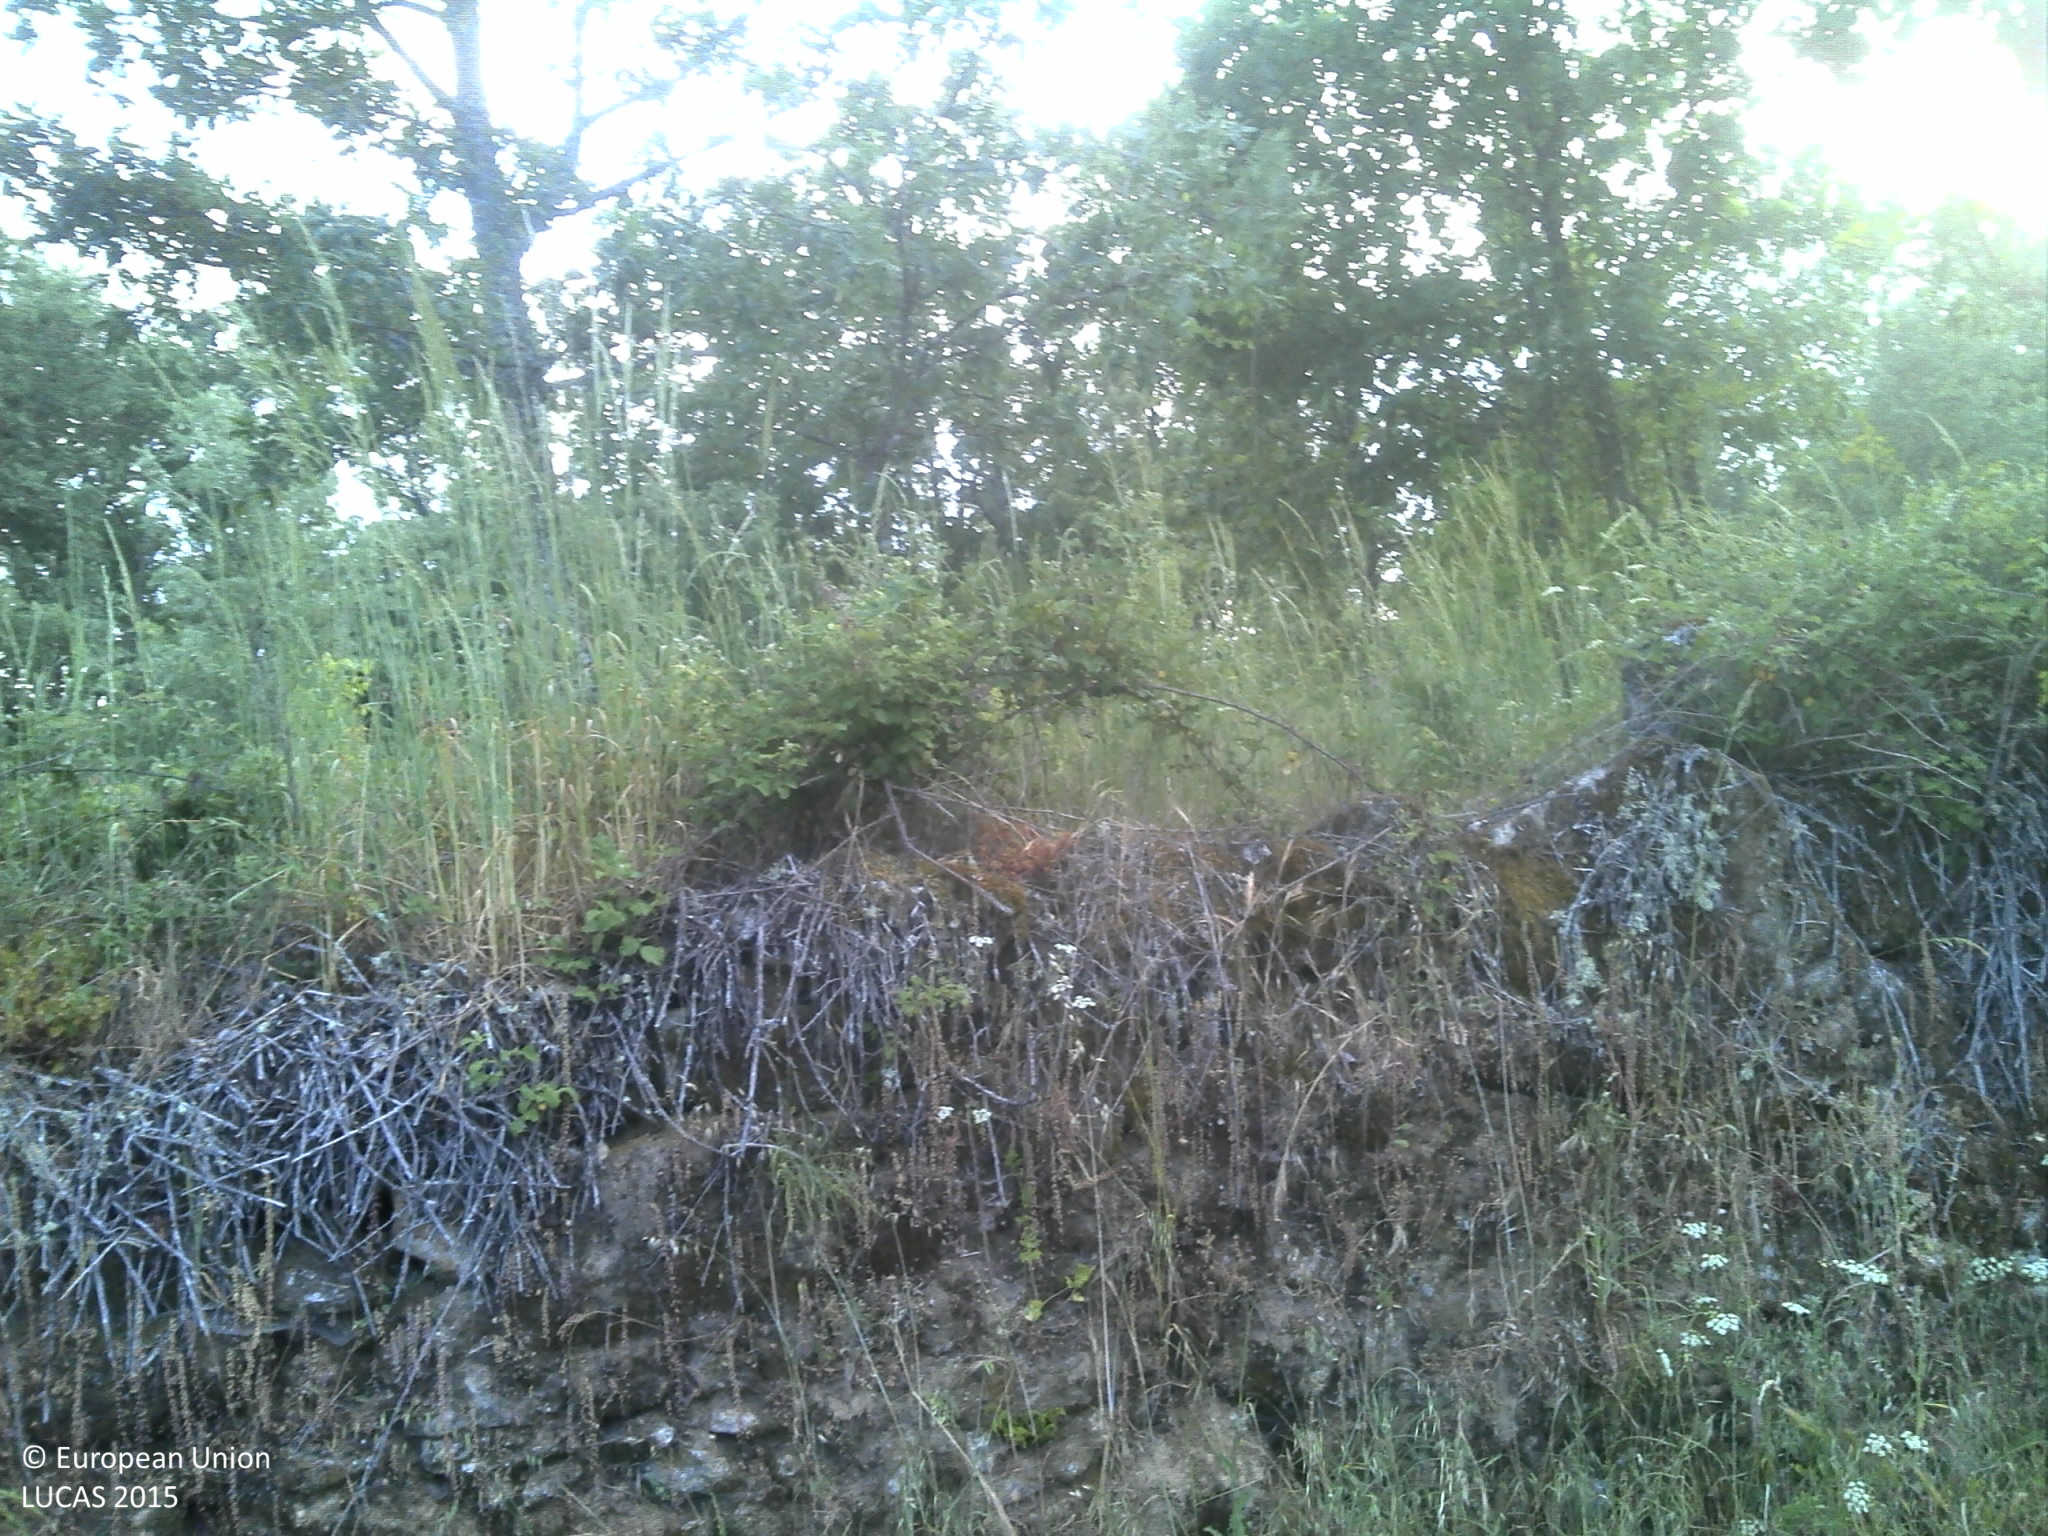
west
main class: Cropland
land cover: Arable land (only in case pi)
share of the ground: 50 - 75 %
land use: Agriculture (excluding fallow land and kitchen gardens)
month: June
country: PT
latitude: 40.4569
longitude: -7.1654
